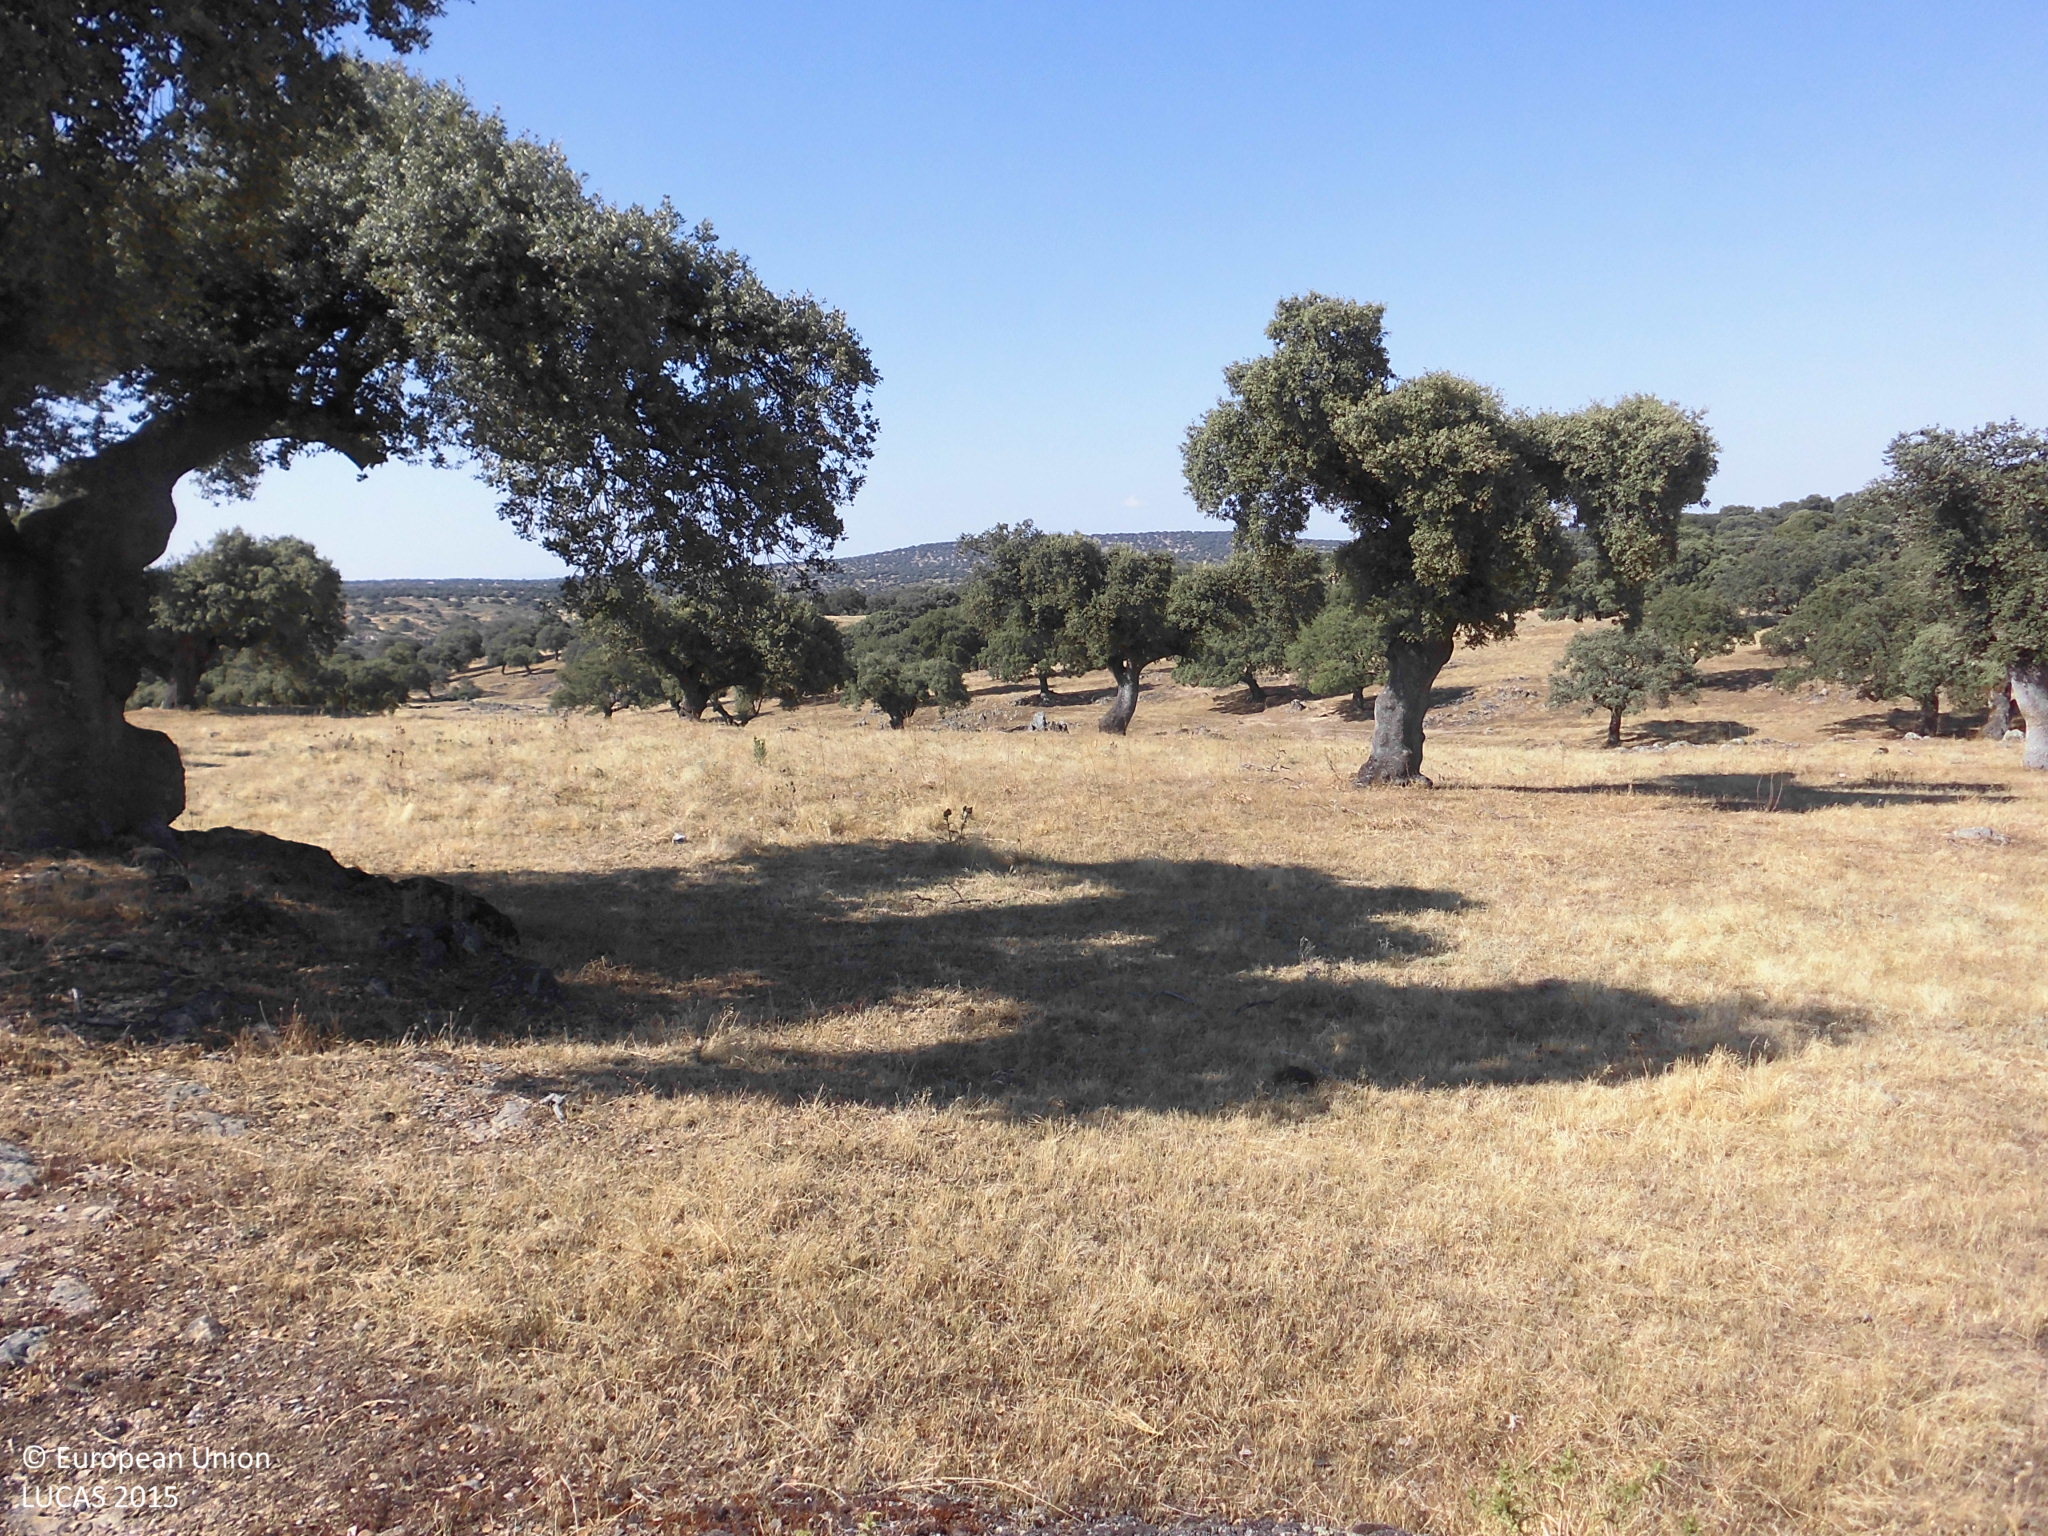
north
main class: Woodland
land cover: Broadleaved woodland
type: broadleaved evergreen forest
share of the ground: 10 - 25 %
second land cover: Grassland without tree/shrub cover
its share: > 75 %
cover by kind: herbaceous plants 80 %, broadleaved forest trees 15 %, consolidated bare surface 5 %
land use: Forestry
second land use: Agriculture (excluding fallow land and kitchen gardens)
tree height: > 5 m
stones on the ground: < 10 %
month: June
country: ES
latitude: 39.6526
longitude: -5.9476
